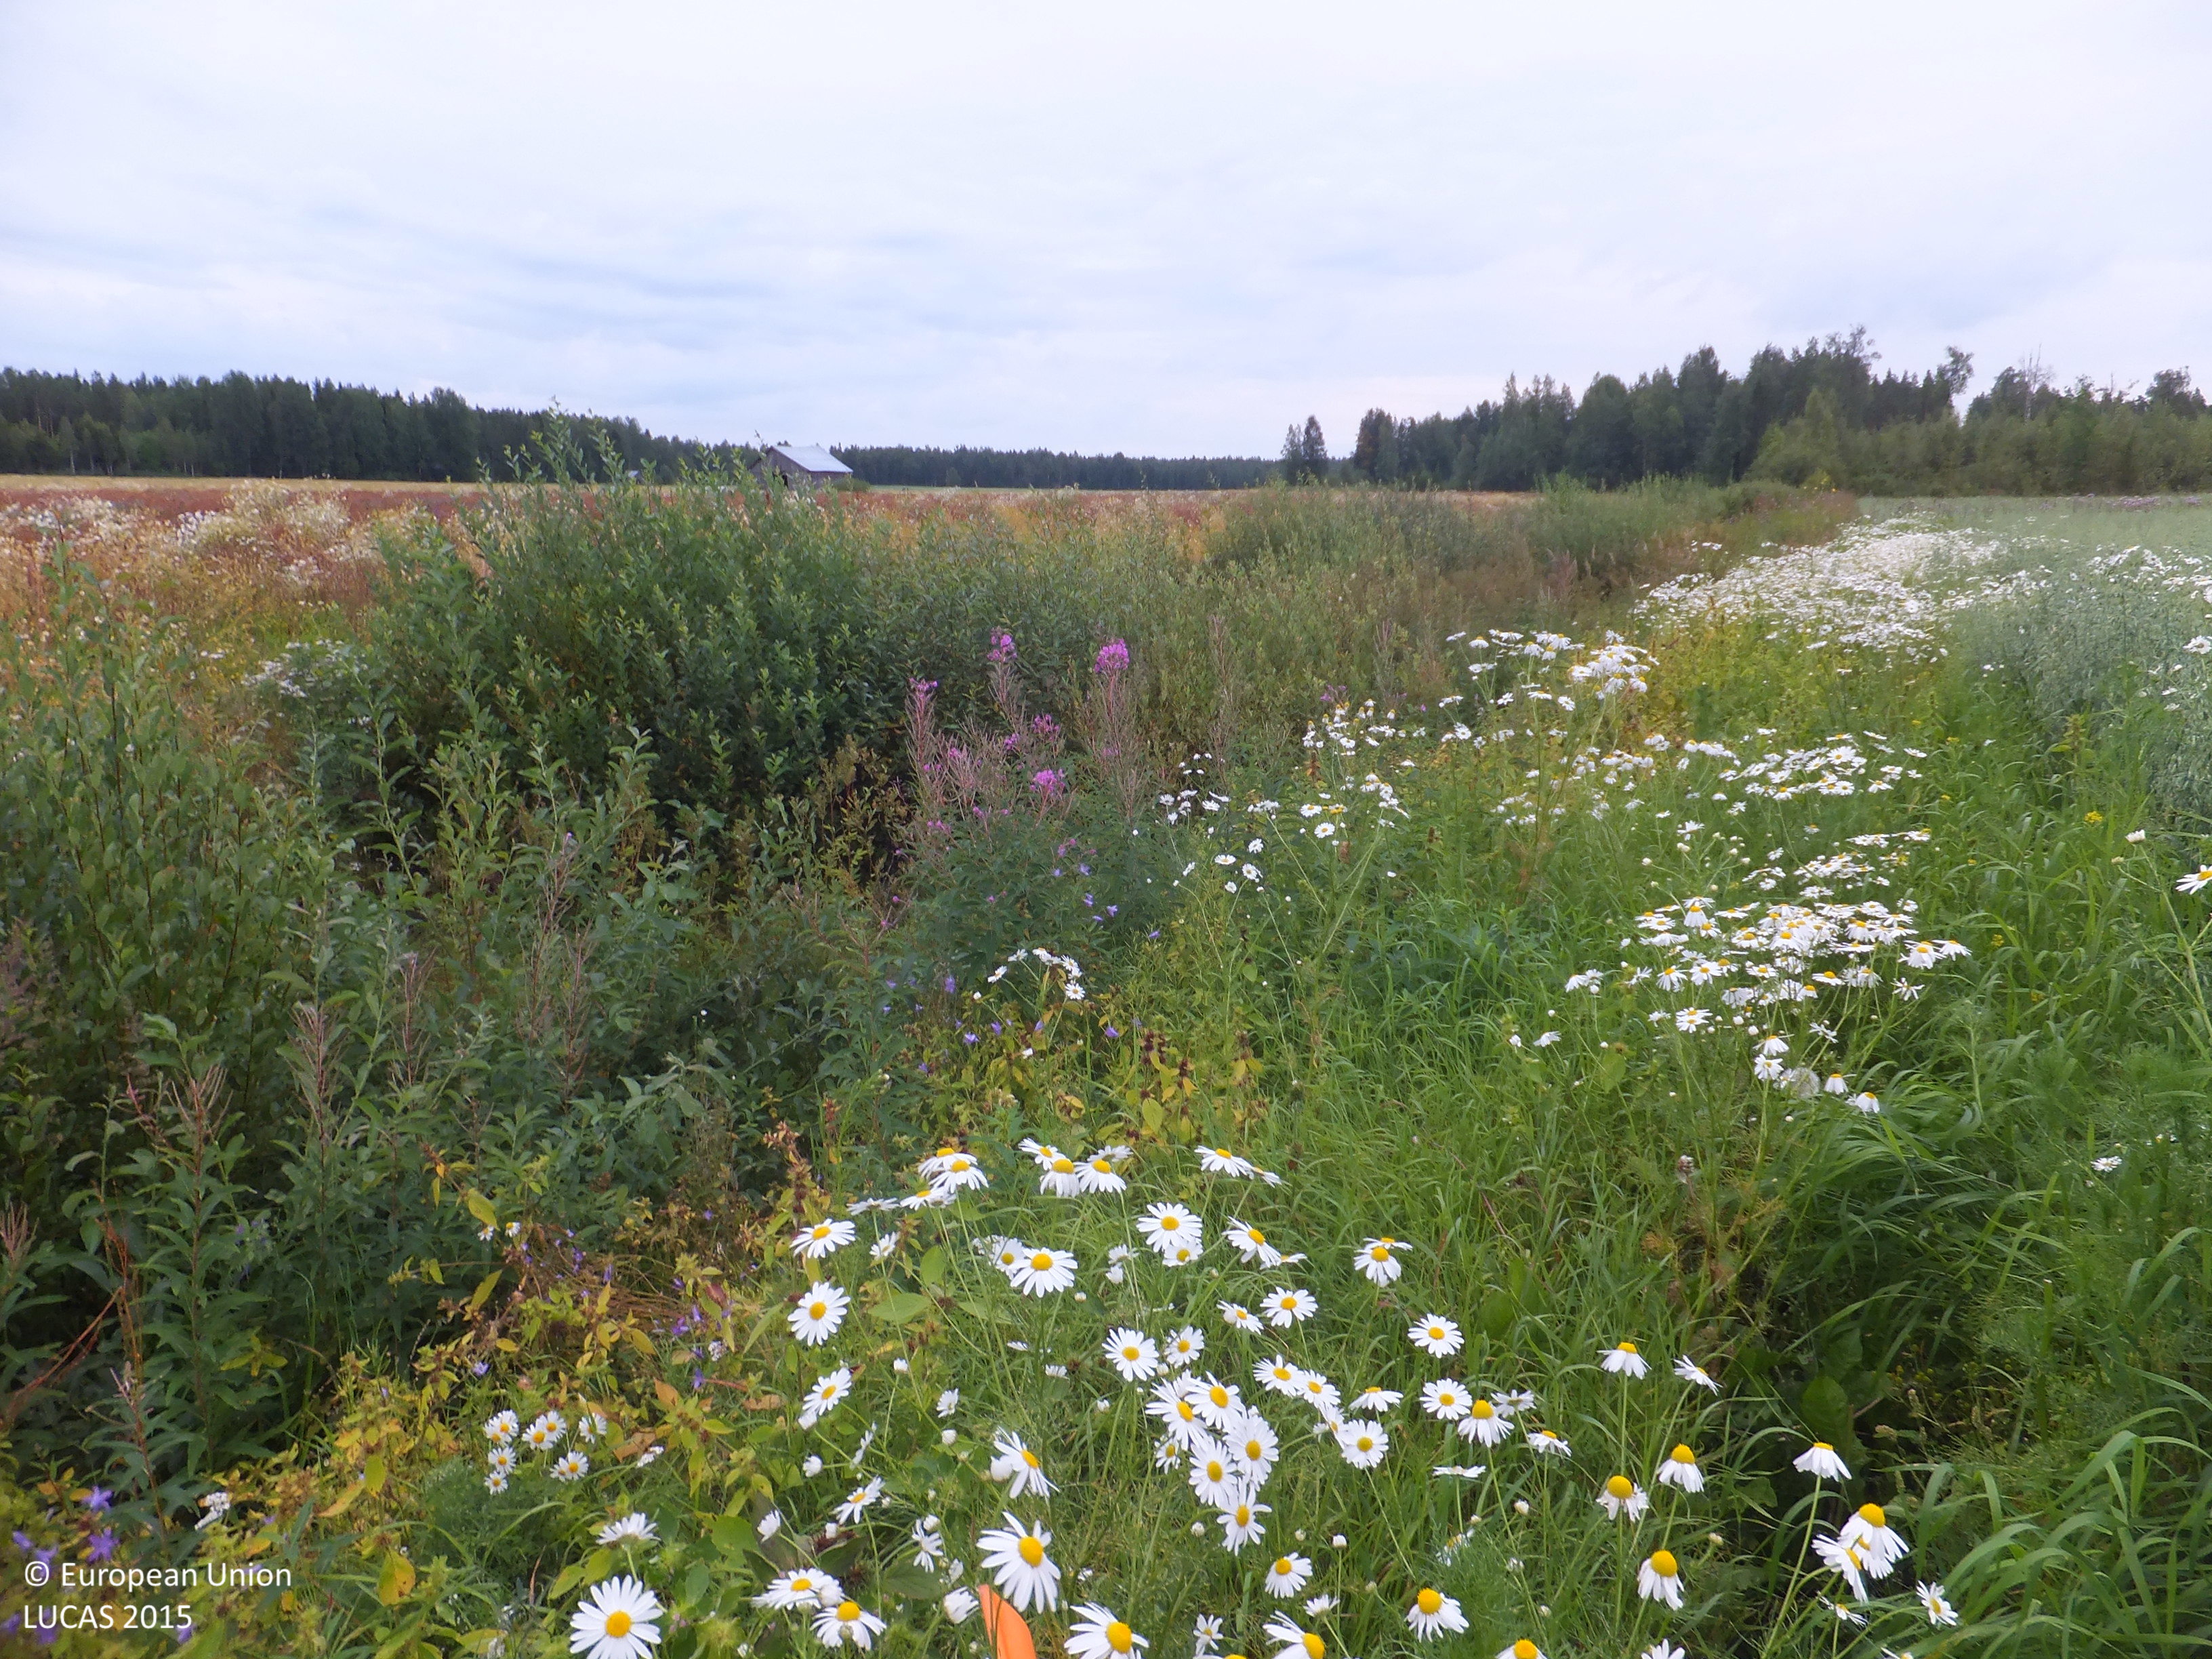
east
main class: Cropland
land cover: Oats
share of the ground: > 75 %
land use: Agriculture (excluding fallow land and kitchen gardens)
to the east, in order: Oats; Grassland without tree/shrub cover; Ditches and canals; Temporary grasslands; Ditches and canals; Grass margins; Paved roads, cycling and walking lanes; Grass margins; Ditches and canals; Grass margins; Temporary grasslands
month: August
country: FI
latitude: 63.0745
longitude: 23.1843
